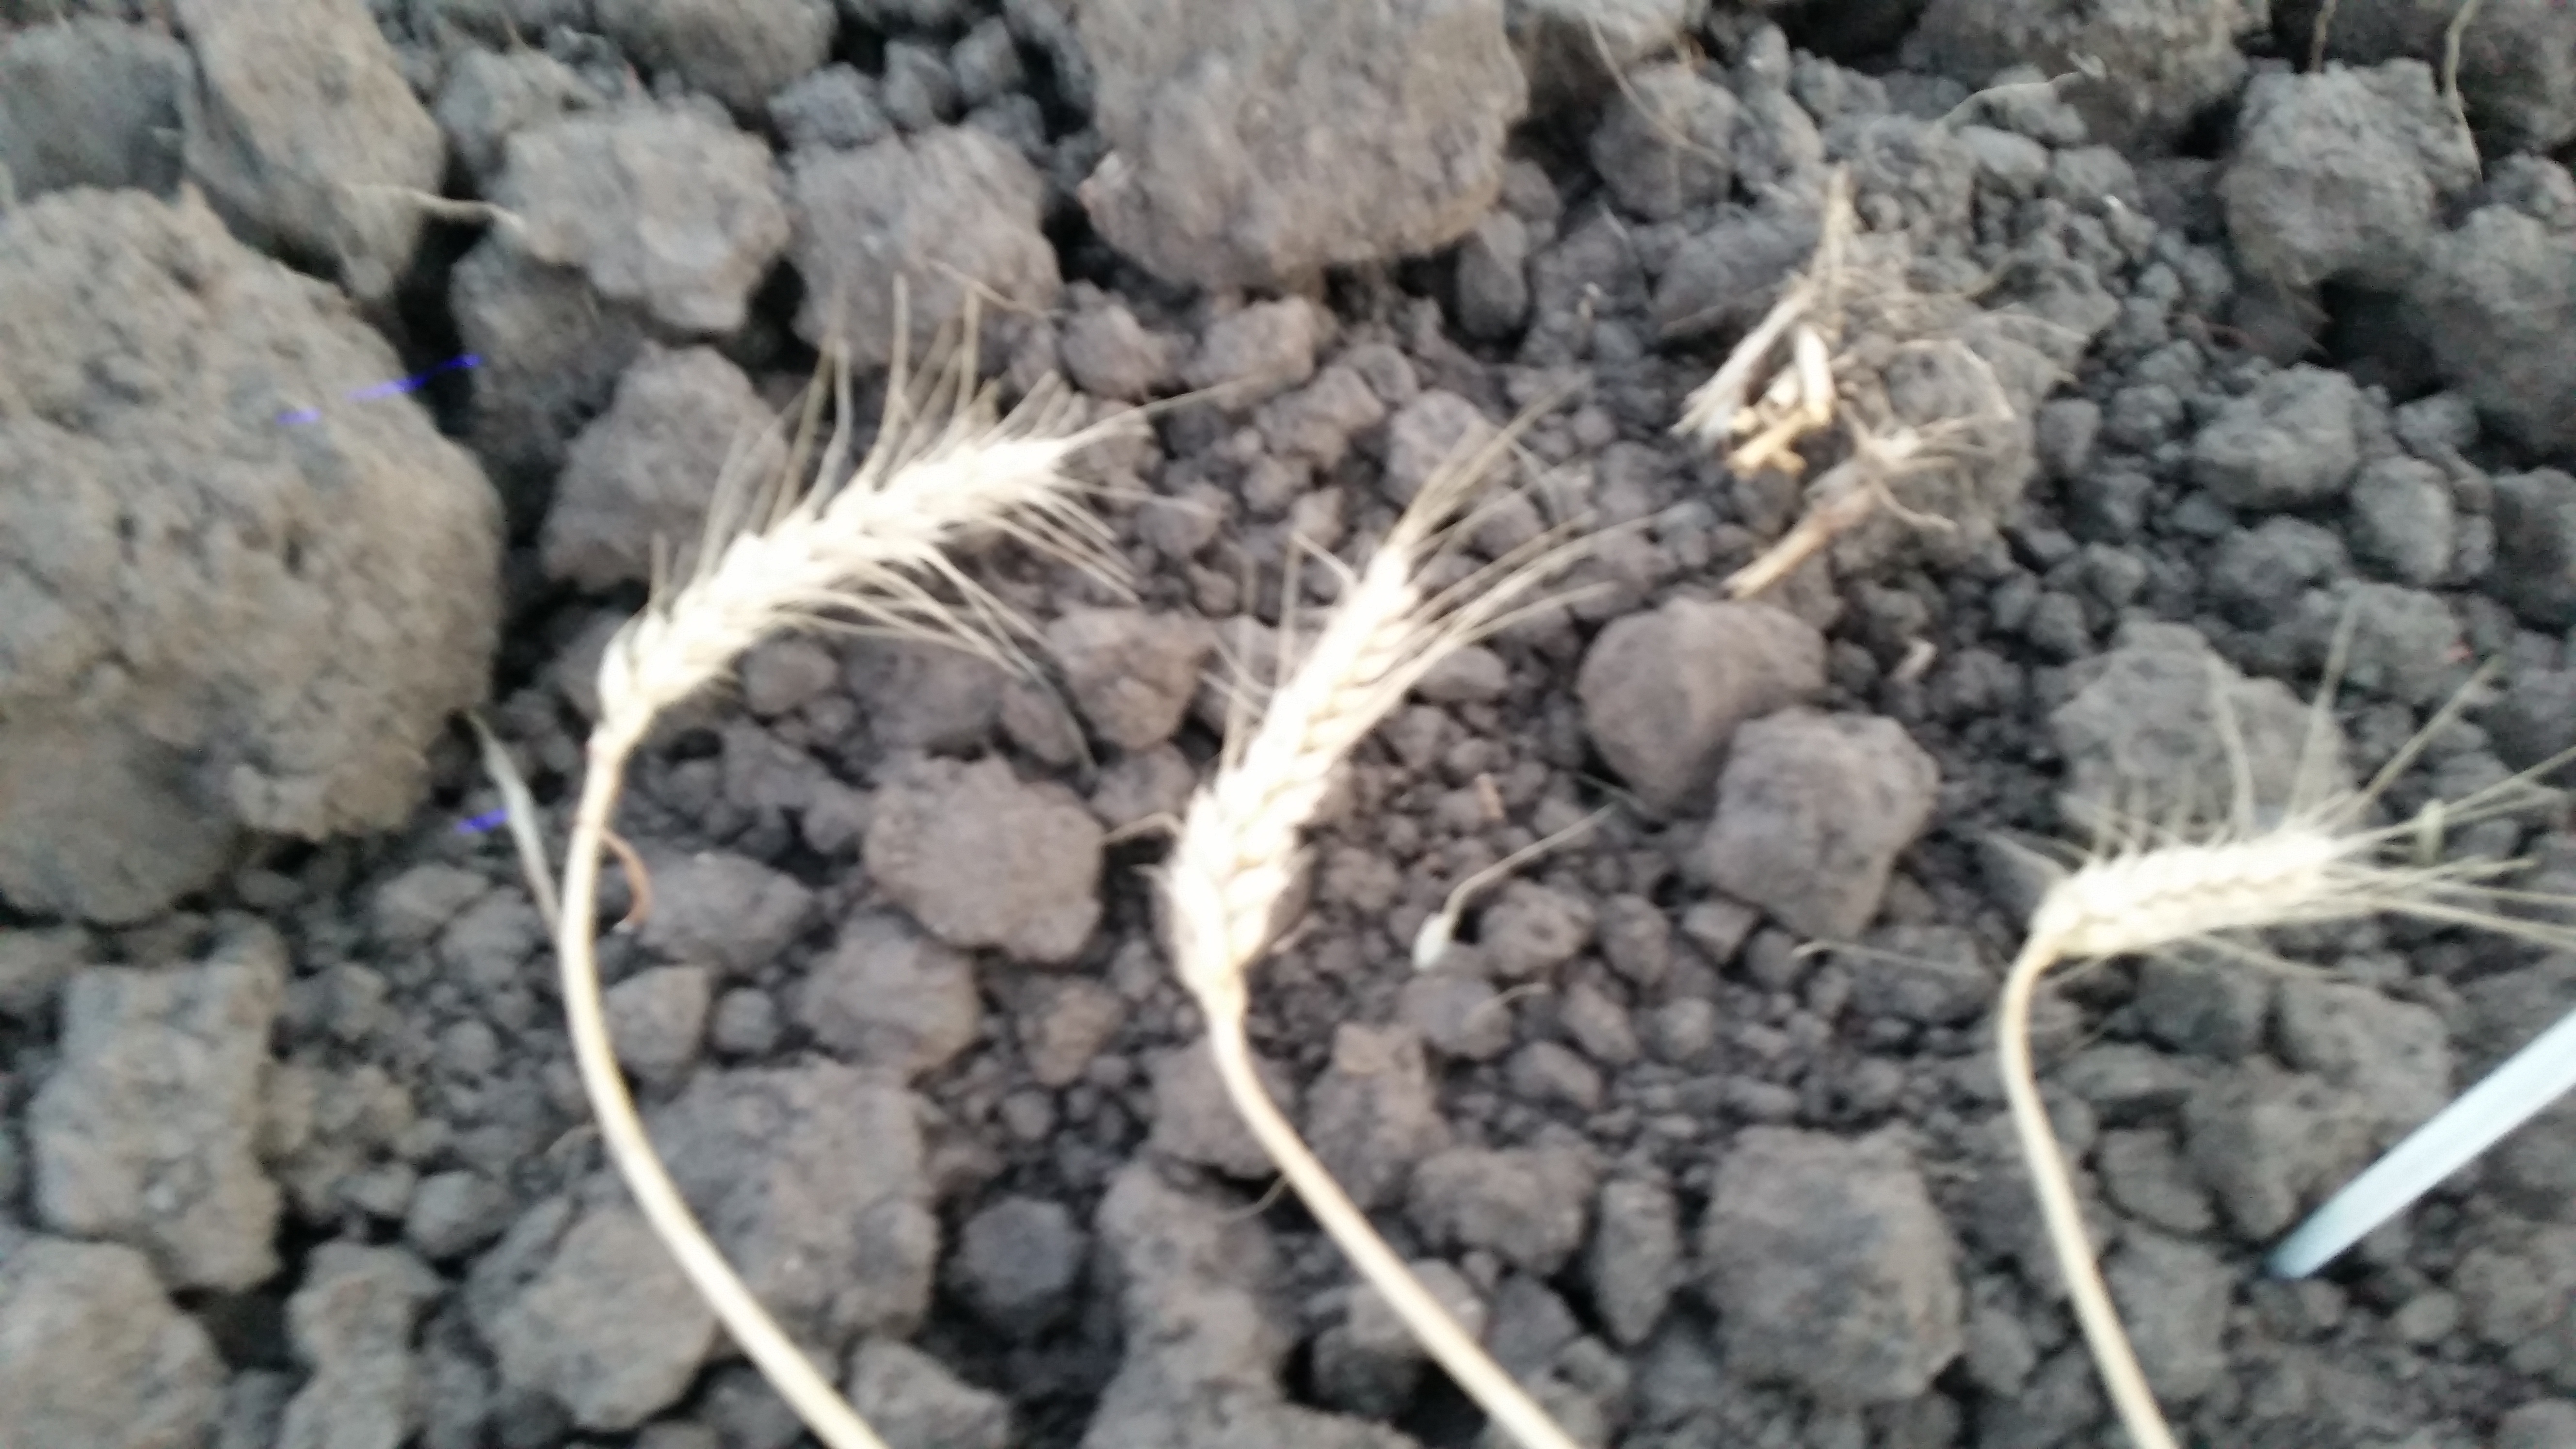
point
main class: Cropland
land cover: Common wheat
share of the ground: < 10 %
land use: Agriculture (excluding fallow land and kitchen gardens)
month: August
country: RO
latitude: 44.0587
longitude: 23.6969
